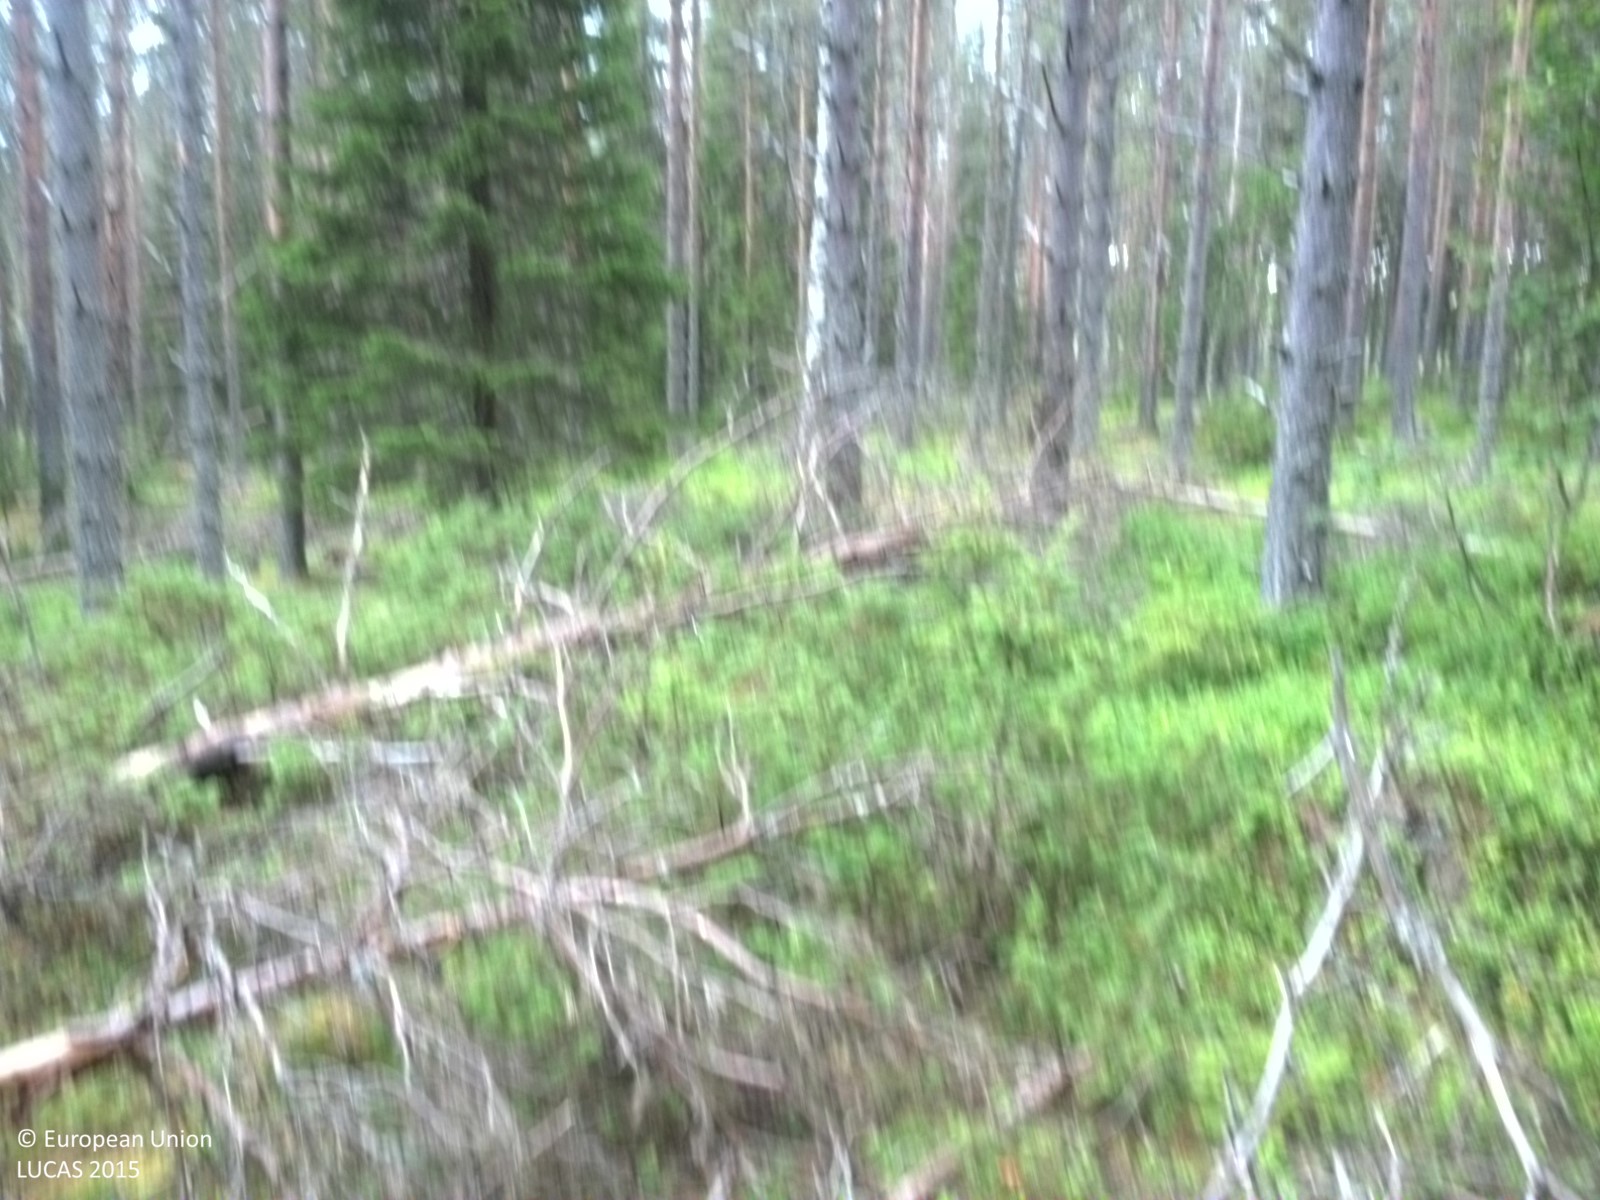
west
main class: Woodland
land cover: Pine dominated coniferous woodland
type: boreal forest
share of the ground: 50 - 75 %
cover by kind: coniferous forest trees 65 %, shrubs 20 %, broadleaved forest trees 10 %, herbaceous plants 5 %
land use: Forestry
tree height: > 5 m
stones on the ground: < 10 %
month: July
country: SE
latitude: 63.7093
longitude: 19.5502
